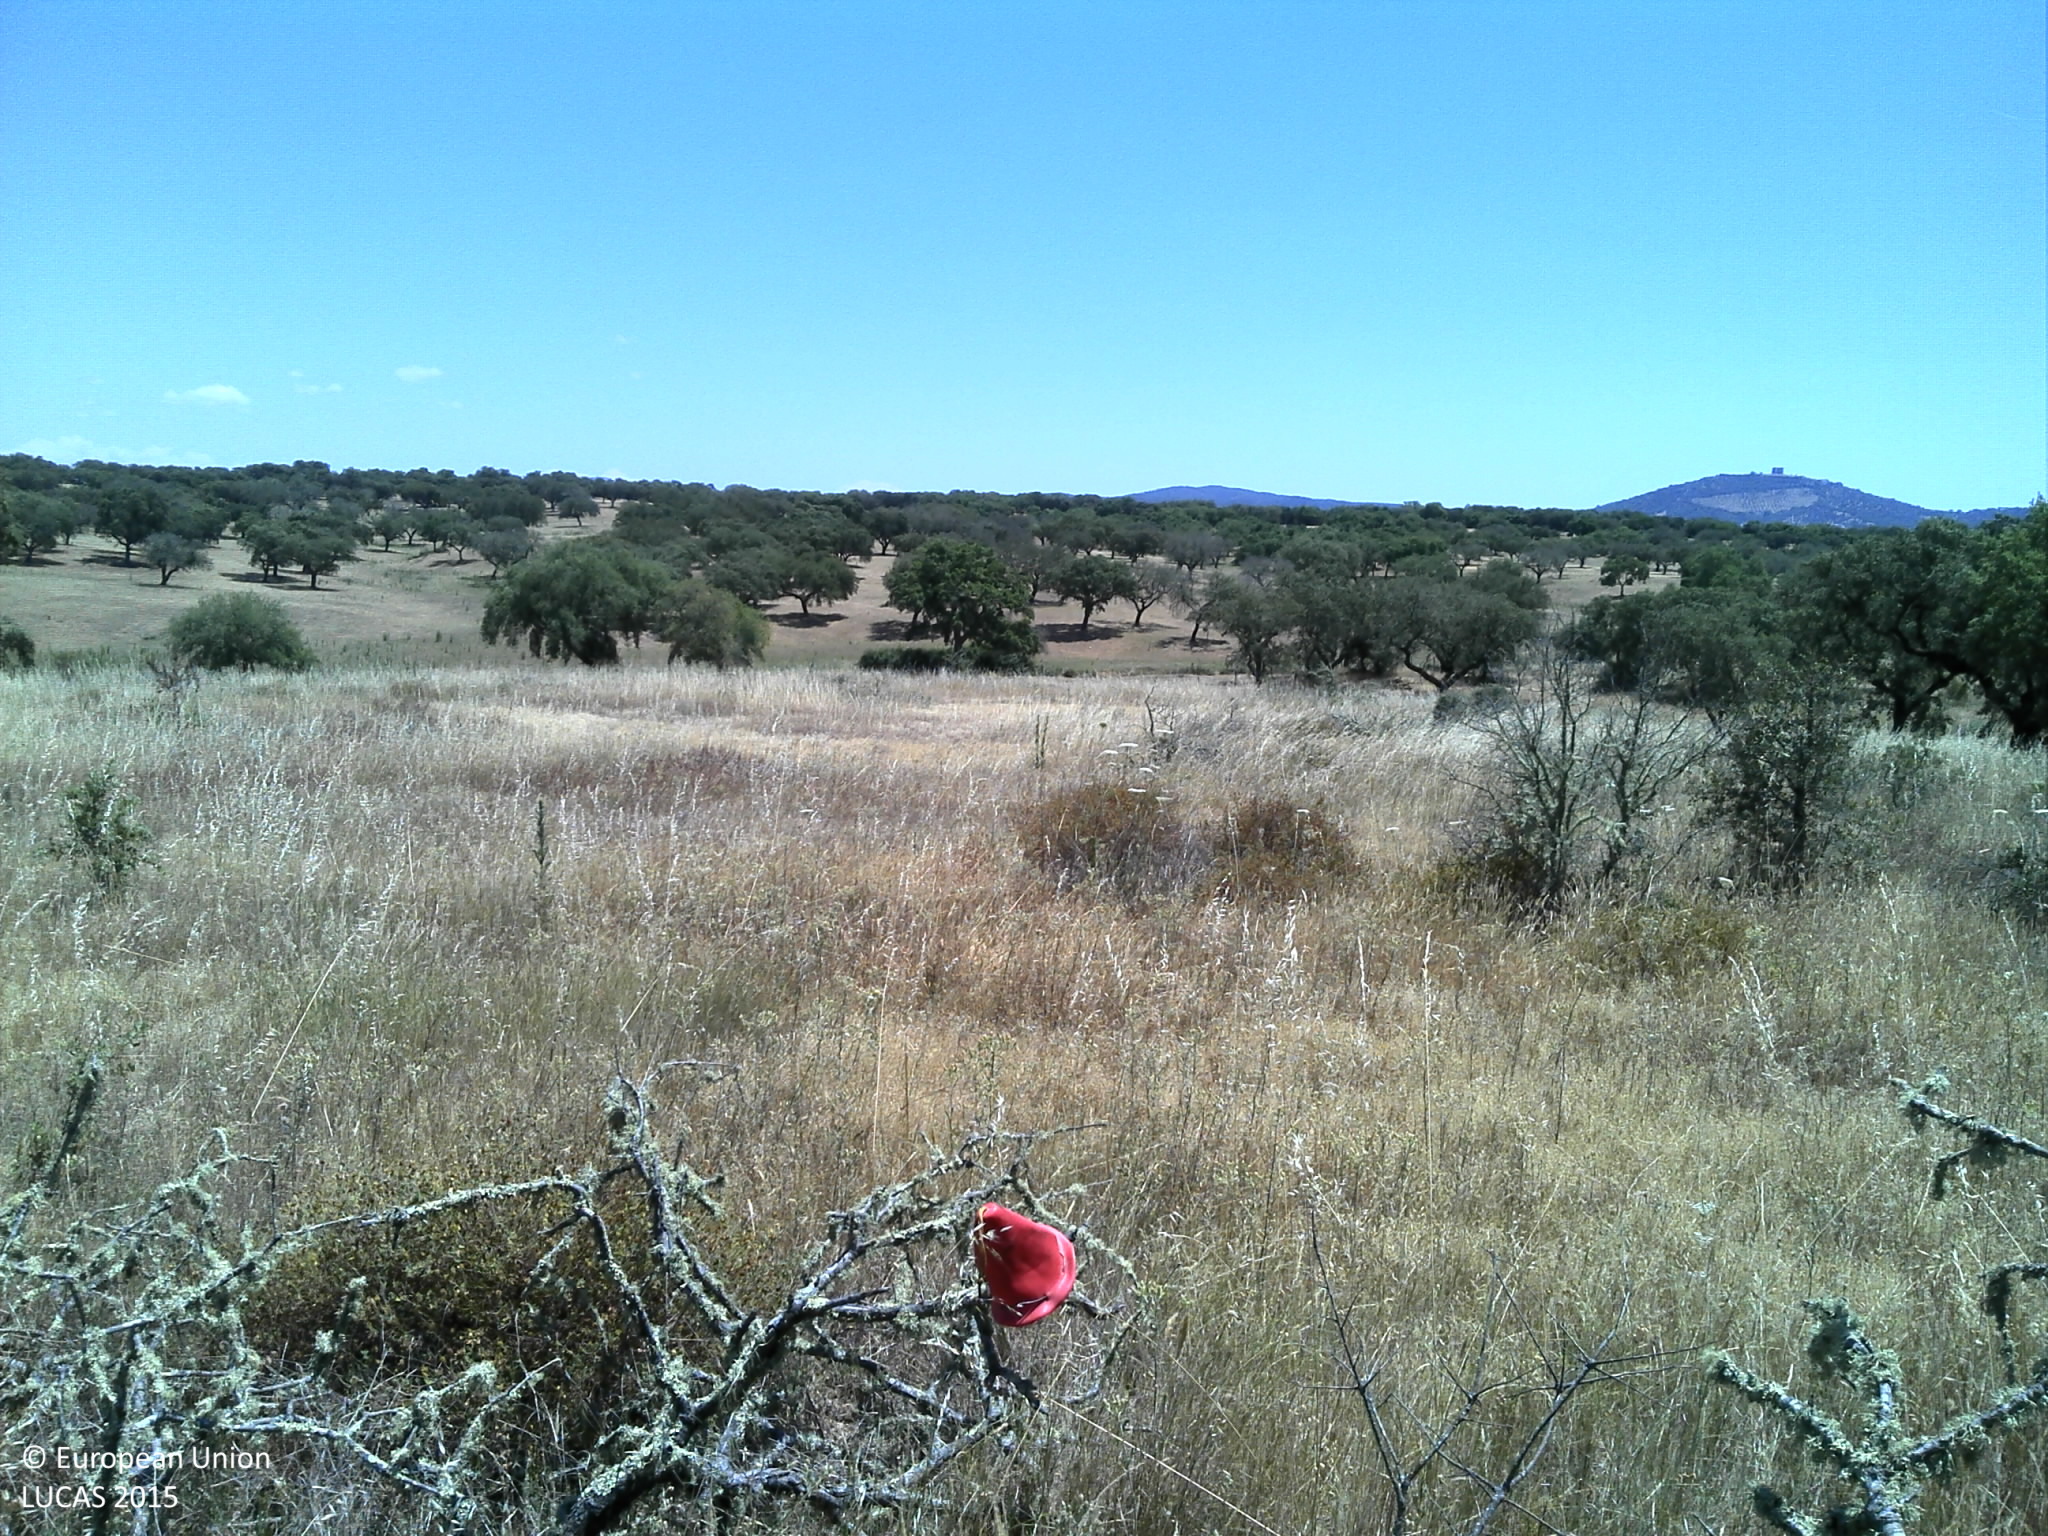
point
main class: Woodland
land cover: Broadleaved woodland
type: broadleaved evergreen forest
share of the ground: 25 - 50 %
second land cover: Grassland without tree/shrub cover
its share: 50 - 75 %
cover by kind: herbaceous plants 75 %, unconsolidated bare surface 15 %, broadleaved forest trees 10 %
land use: Forestry
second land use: Agriculture (excluding fallow land and kitchen gardens)
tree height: > 5 m
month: June
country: PT
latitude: 38.8202
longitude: -7.7428
